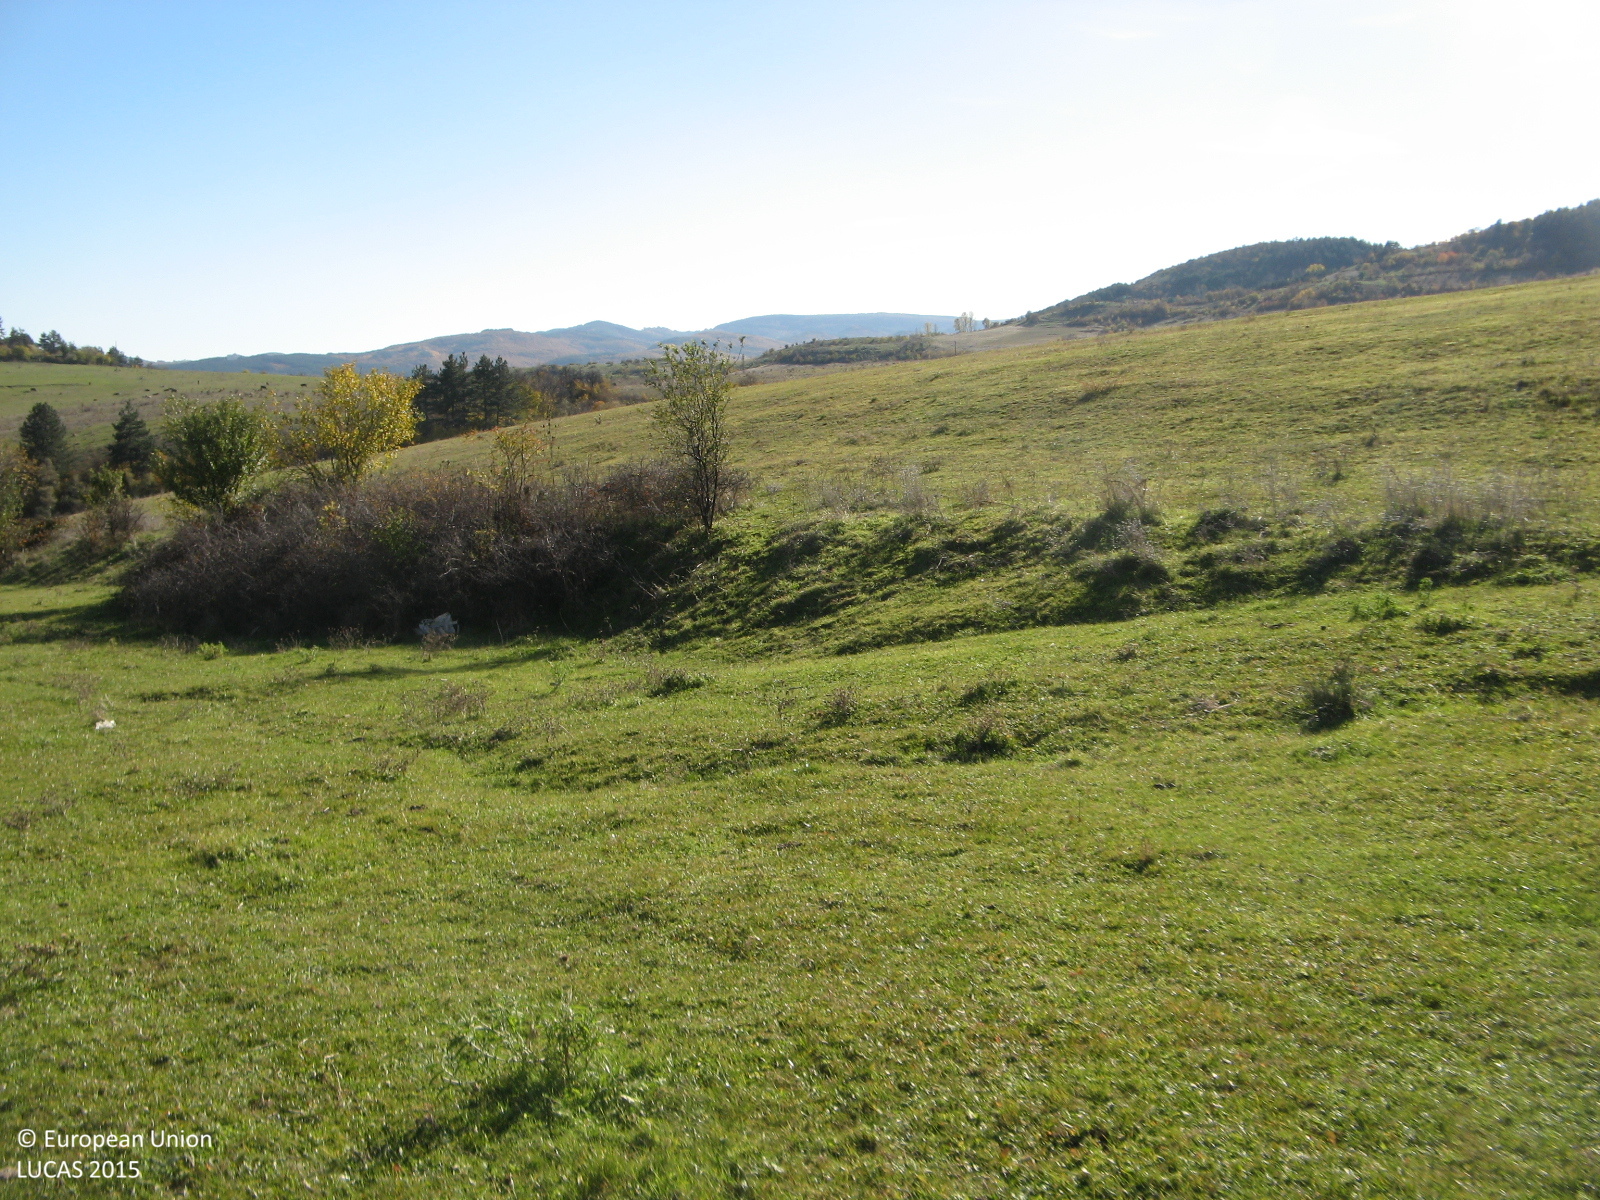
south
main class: Grassland
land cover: Grassland without tree/shrub cover
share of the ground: > 75 %
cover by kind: herbaceous plants 100 %
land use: Agriculture (excluding fallow land and kitchen gardens)
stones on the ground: < 10 %
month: November
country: BG
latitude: 41.7626
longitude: 25.3948
